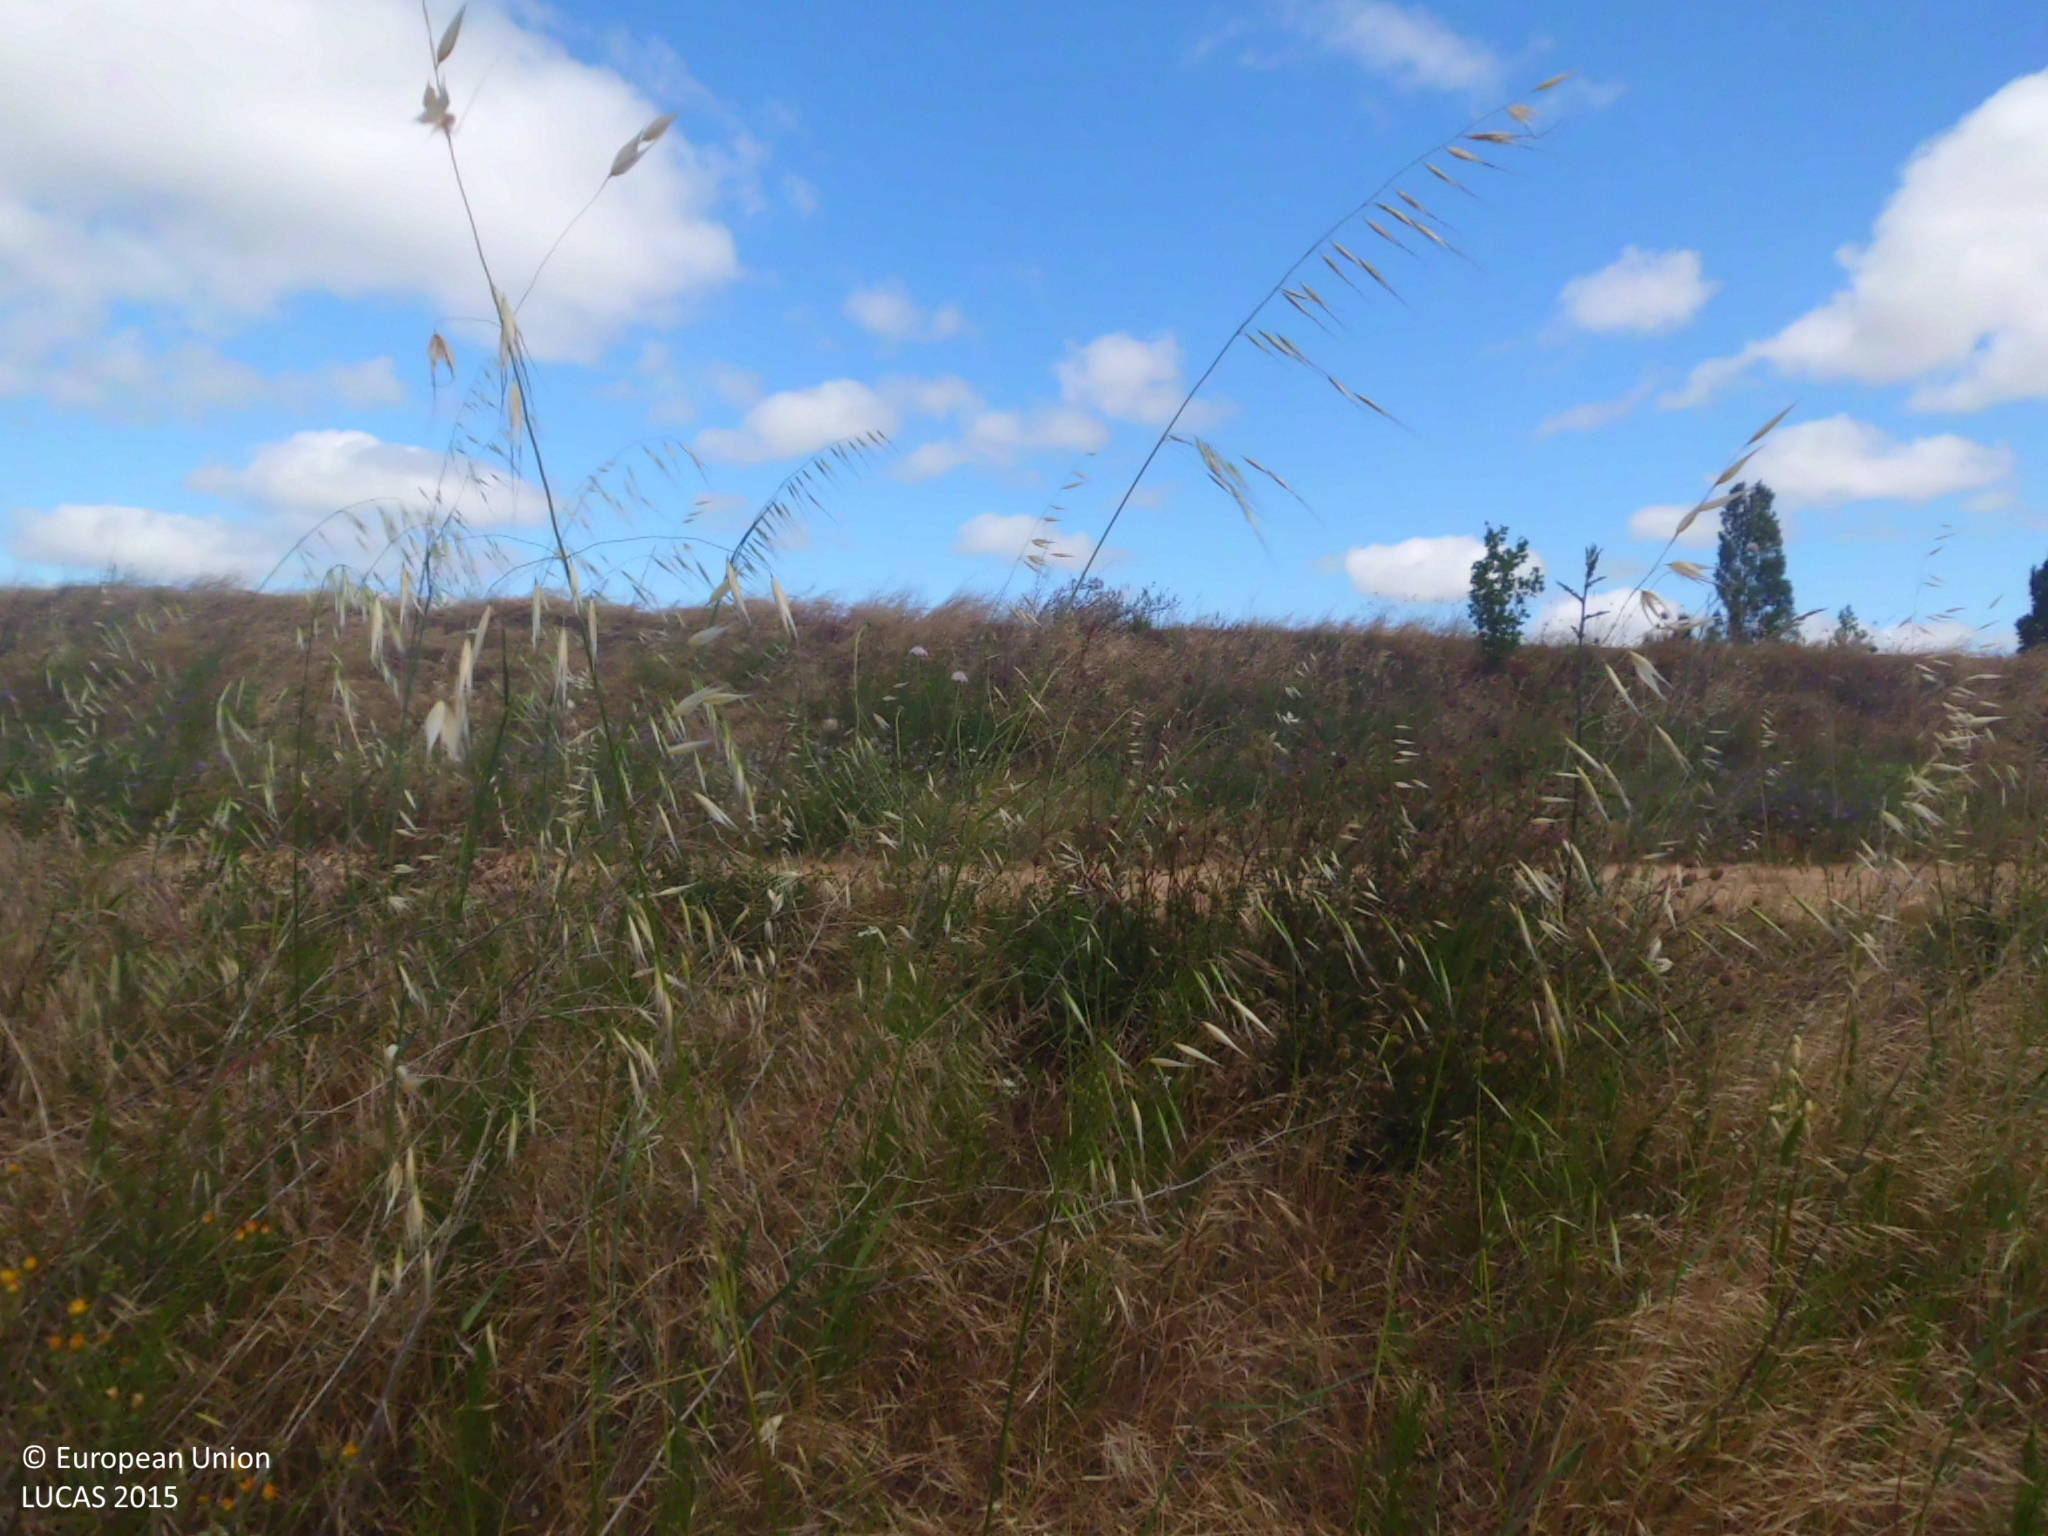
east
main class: Grassland
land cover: Grassland with sparse tree/shrub cover
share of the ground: > 75 %
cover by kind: herbaceous plants 80 %, consolidated bare surface 15 %, broadleaved forest trees 5 %
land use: Agriculture (excluding fallow land and kitchen gardens)
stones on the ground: < 10 %
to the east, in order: Grassland with sparse tree/shrub cover; Tracks; Grass margins; Sunflower
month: June
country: ES
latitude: 42.6799
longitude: -3.3486
